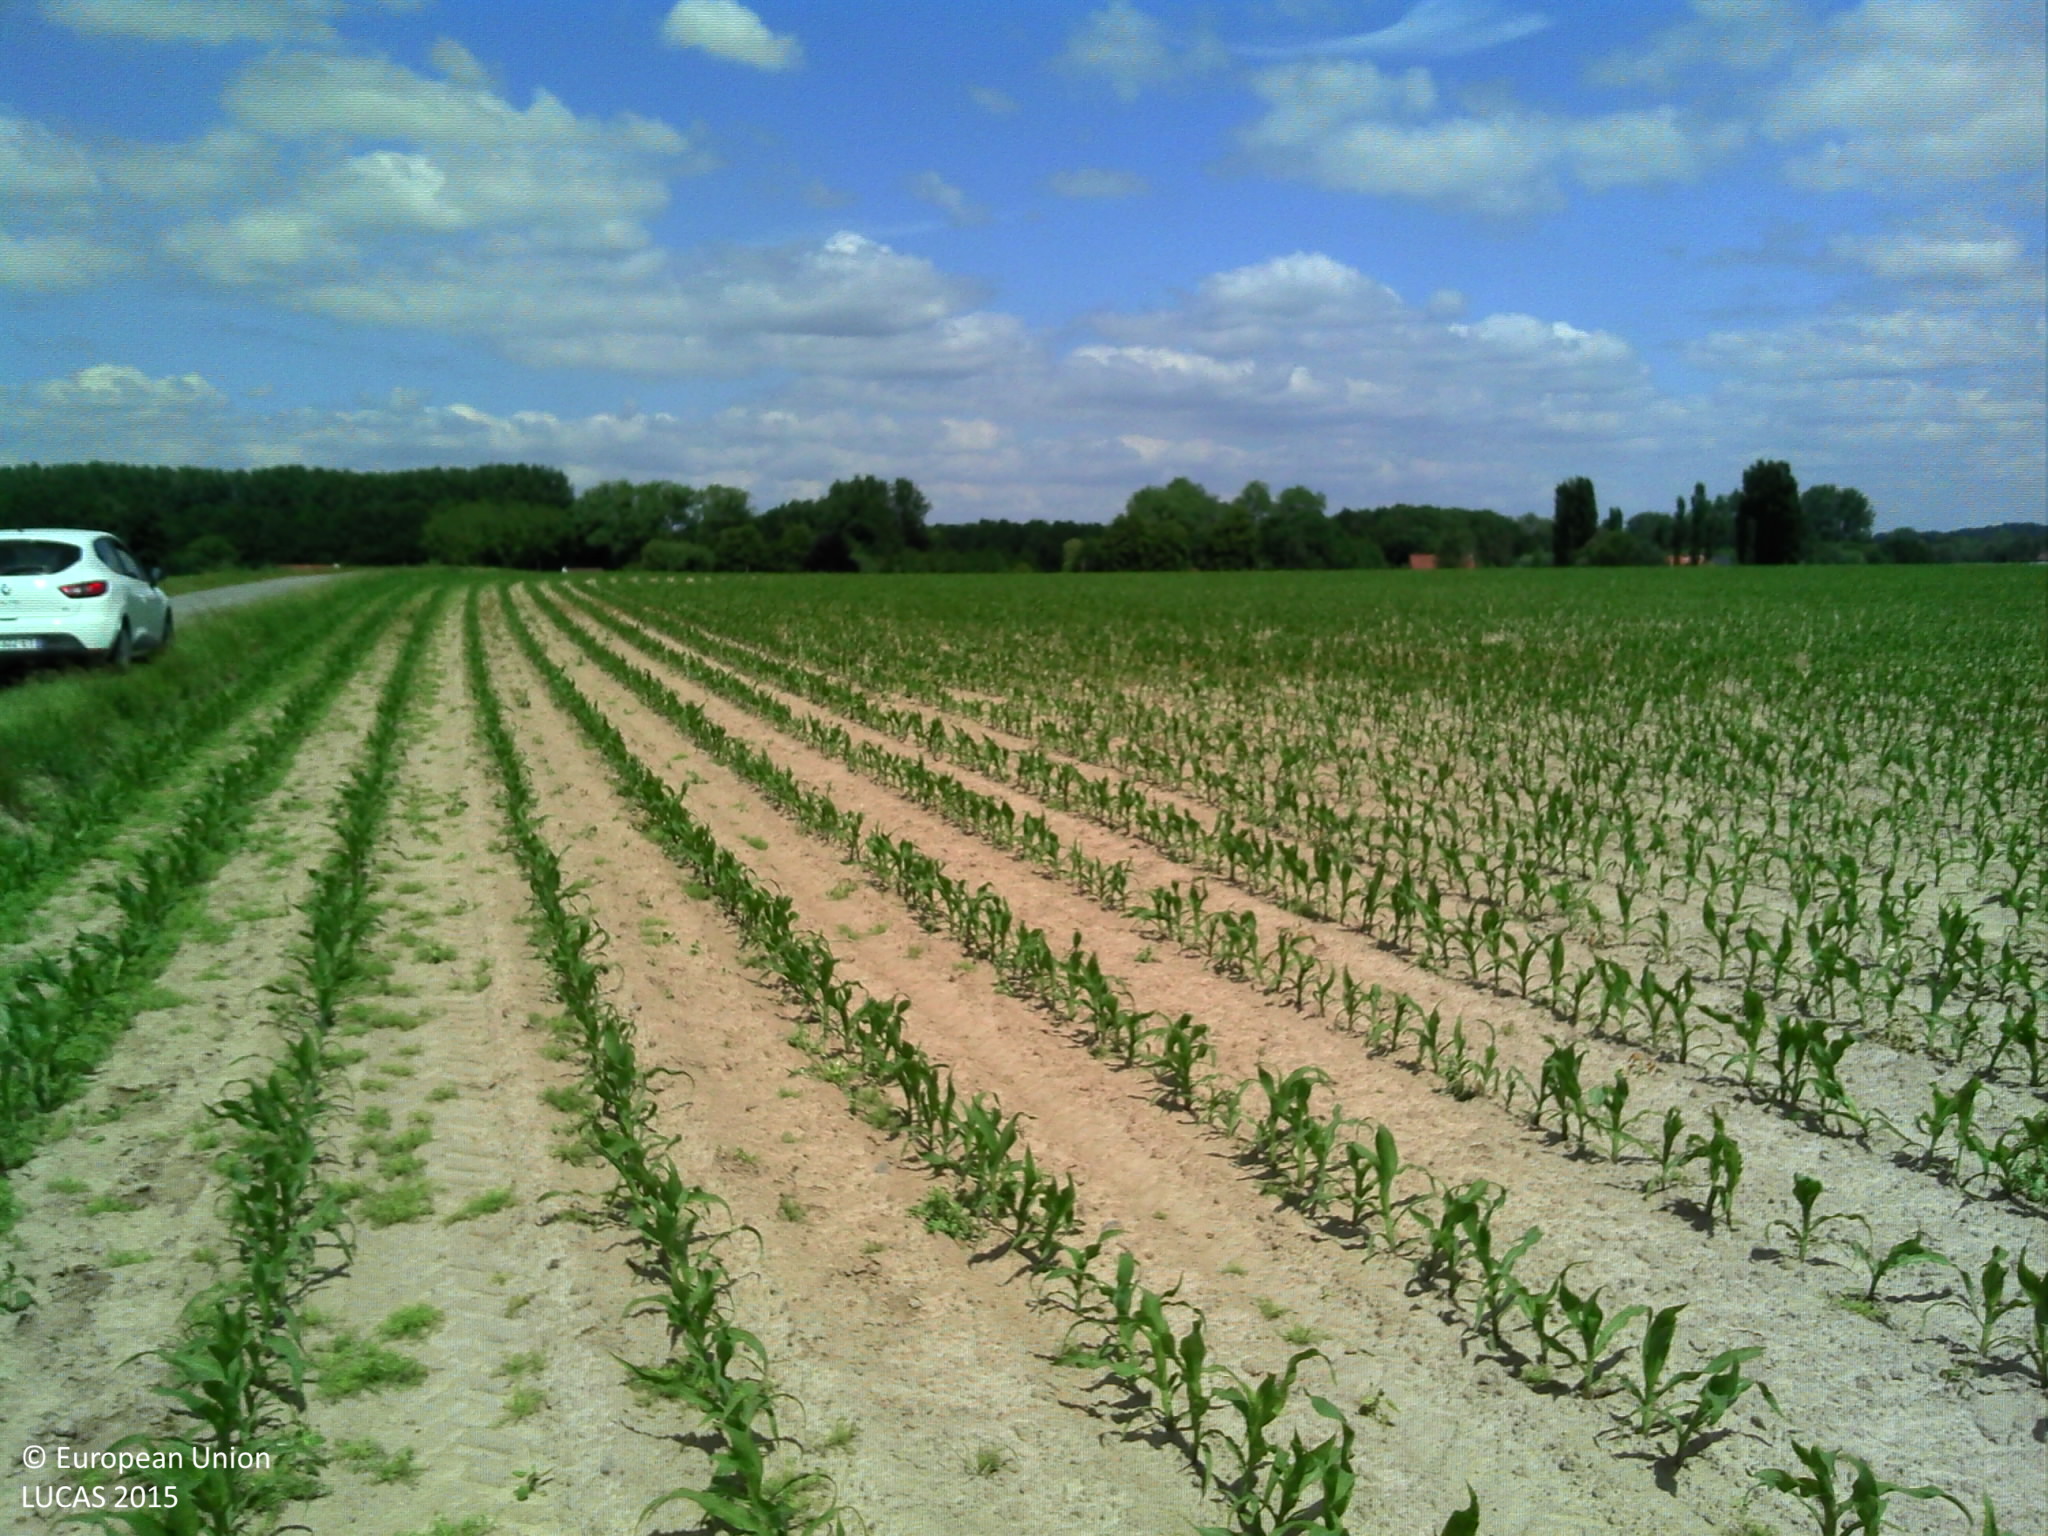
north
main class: Cropland
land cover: Maize
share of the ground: 25 - 50 %
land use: Agriculture (excluding fallow land and kitchen gardens)
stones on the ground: < 10 %
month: June
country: BE
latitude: 50.8904
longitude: 3.6381
